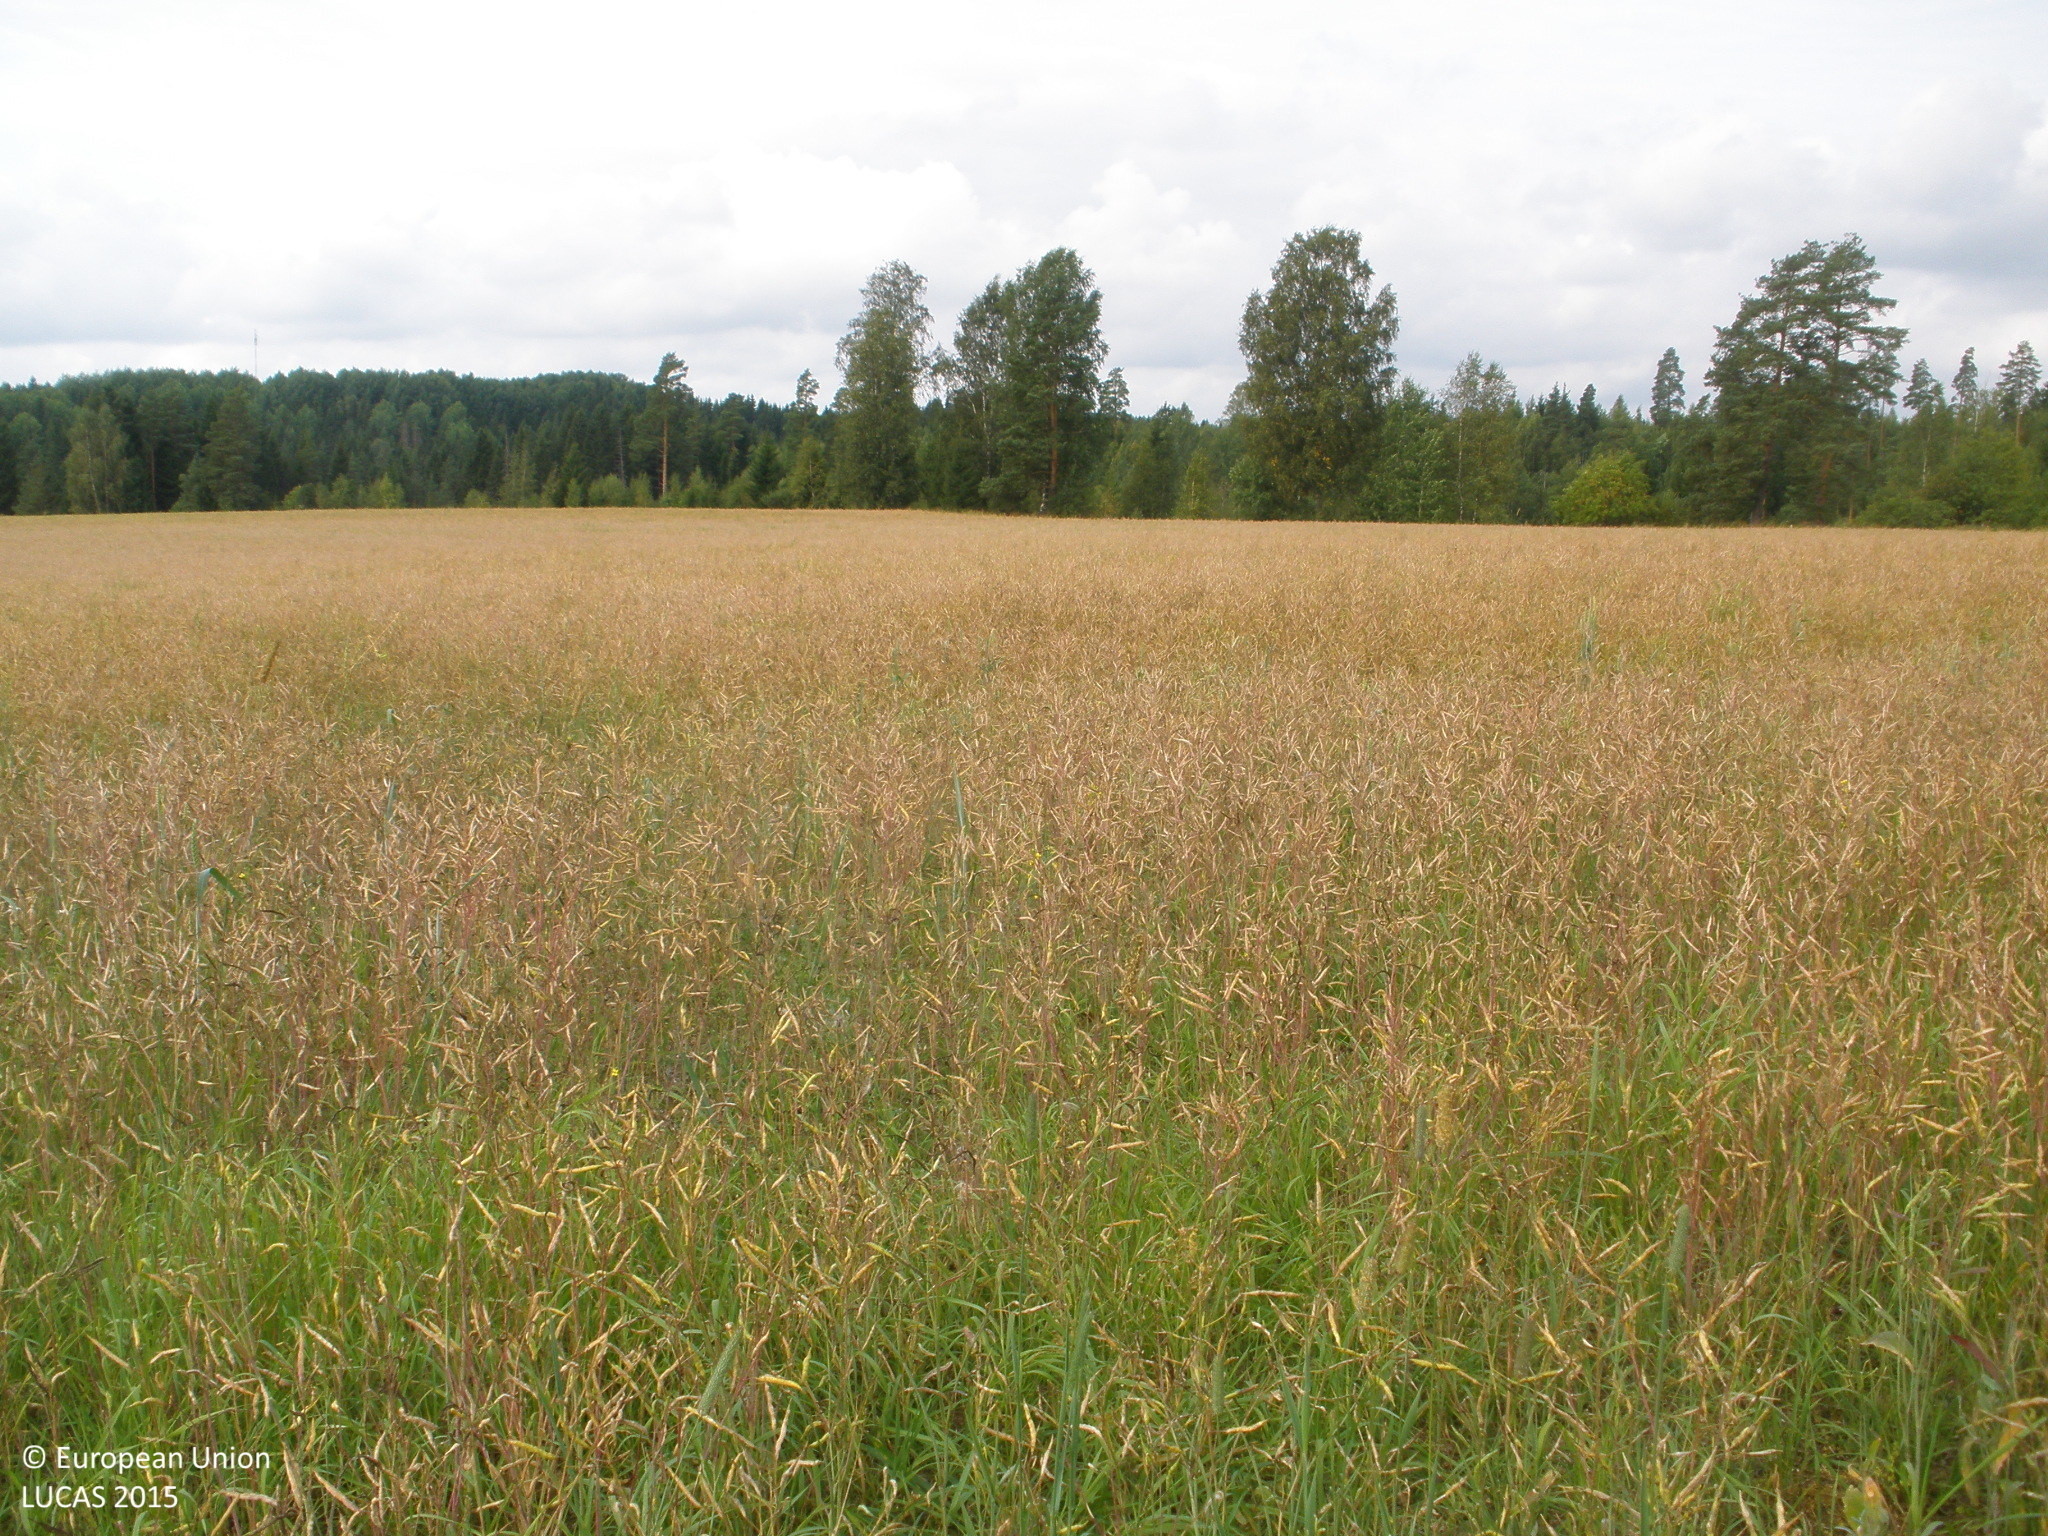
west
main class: Cropland
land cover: Dry pulses
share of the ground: > 75 %
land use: Agriculture (excluding fallow land and kitchen gardens)
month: August
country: FI
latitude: 60.5607
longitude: 23.4179
